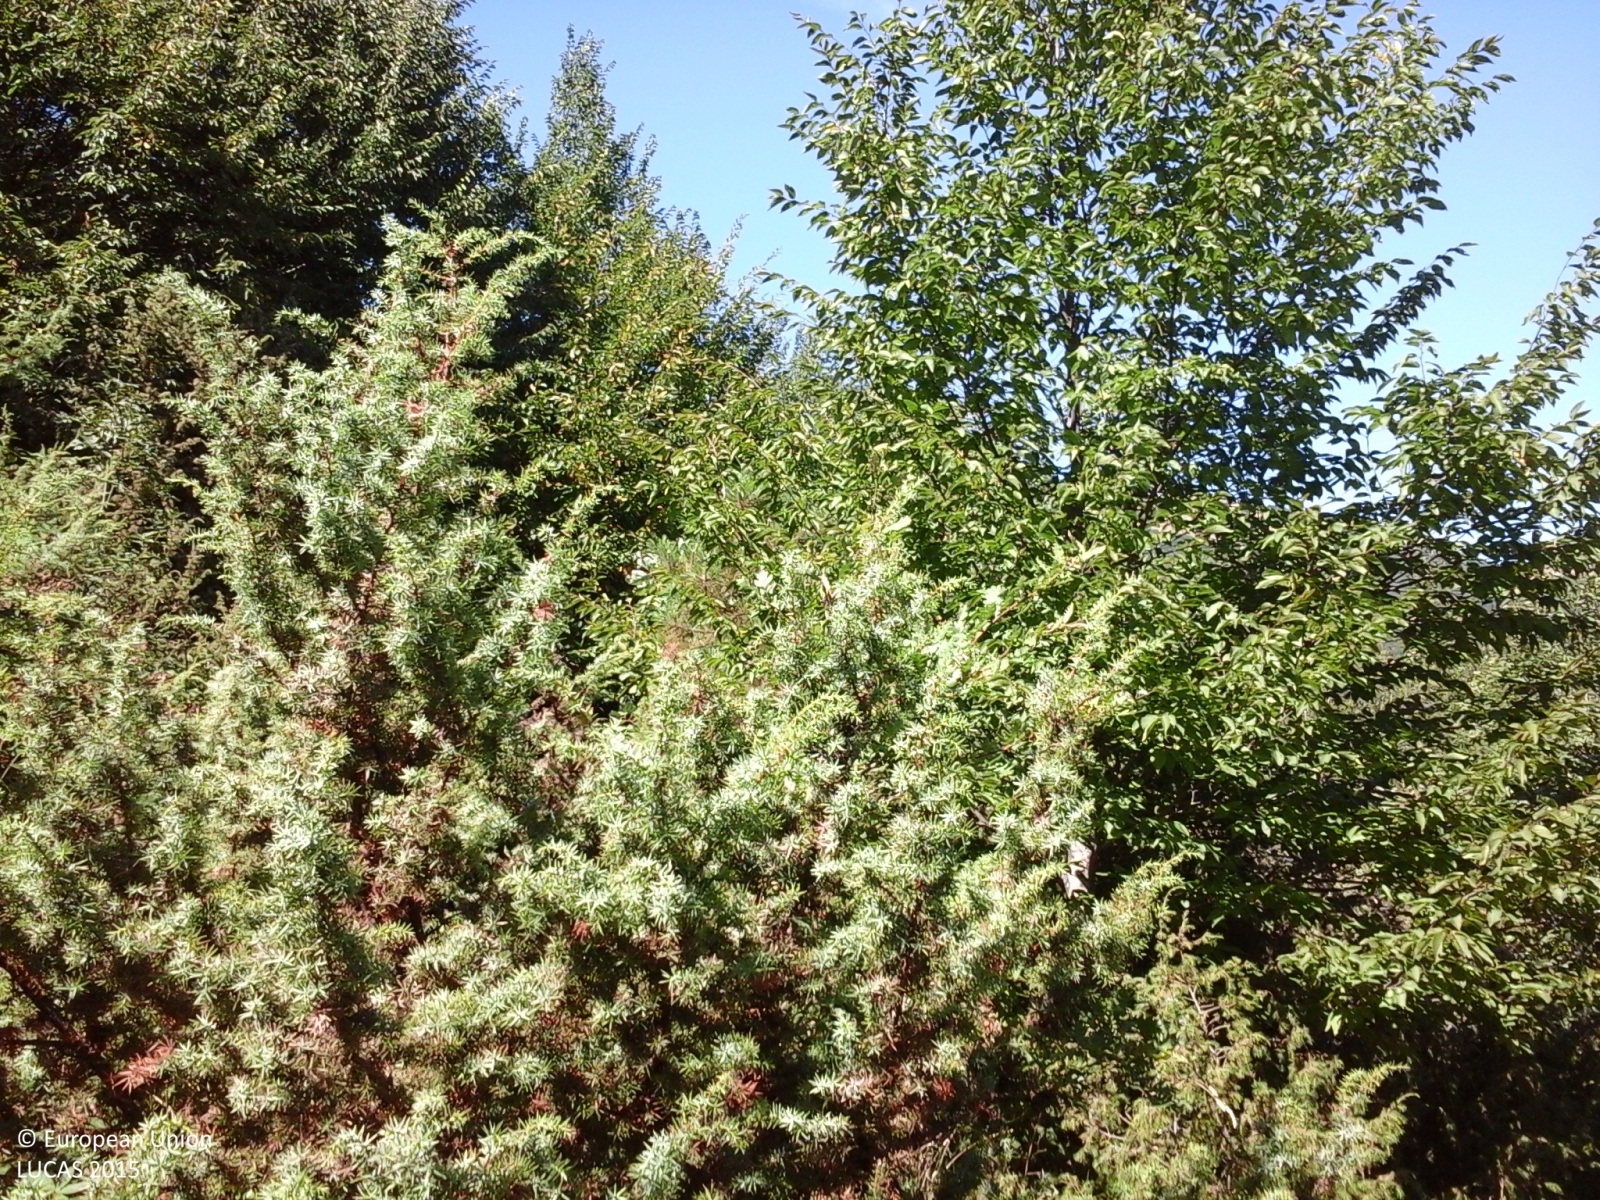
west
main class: Woodland
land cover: Broadleaved woodland
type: thermophilous deciduous forest
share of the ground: > 75 %
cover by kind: broadleaved forest trees 95 %, coniferous forest trees 5 %
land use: Forestry
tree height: > 5 m
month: August
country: IT
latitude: 43.2064
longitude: 12.9827
